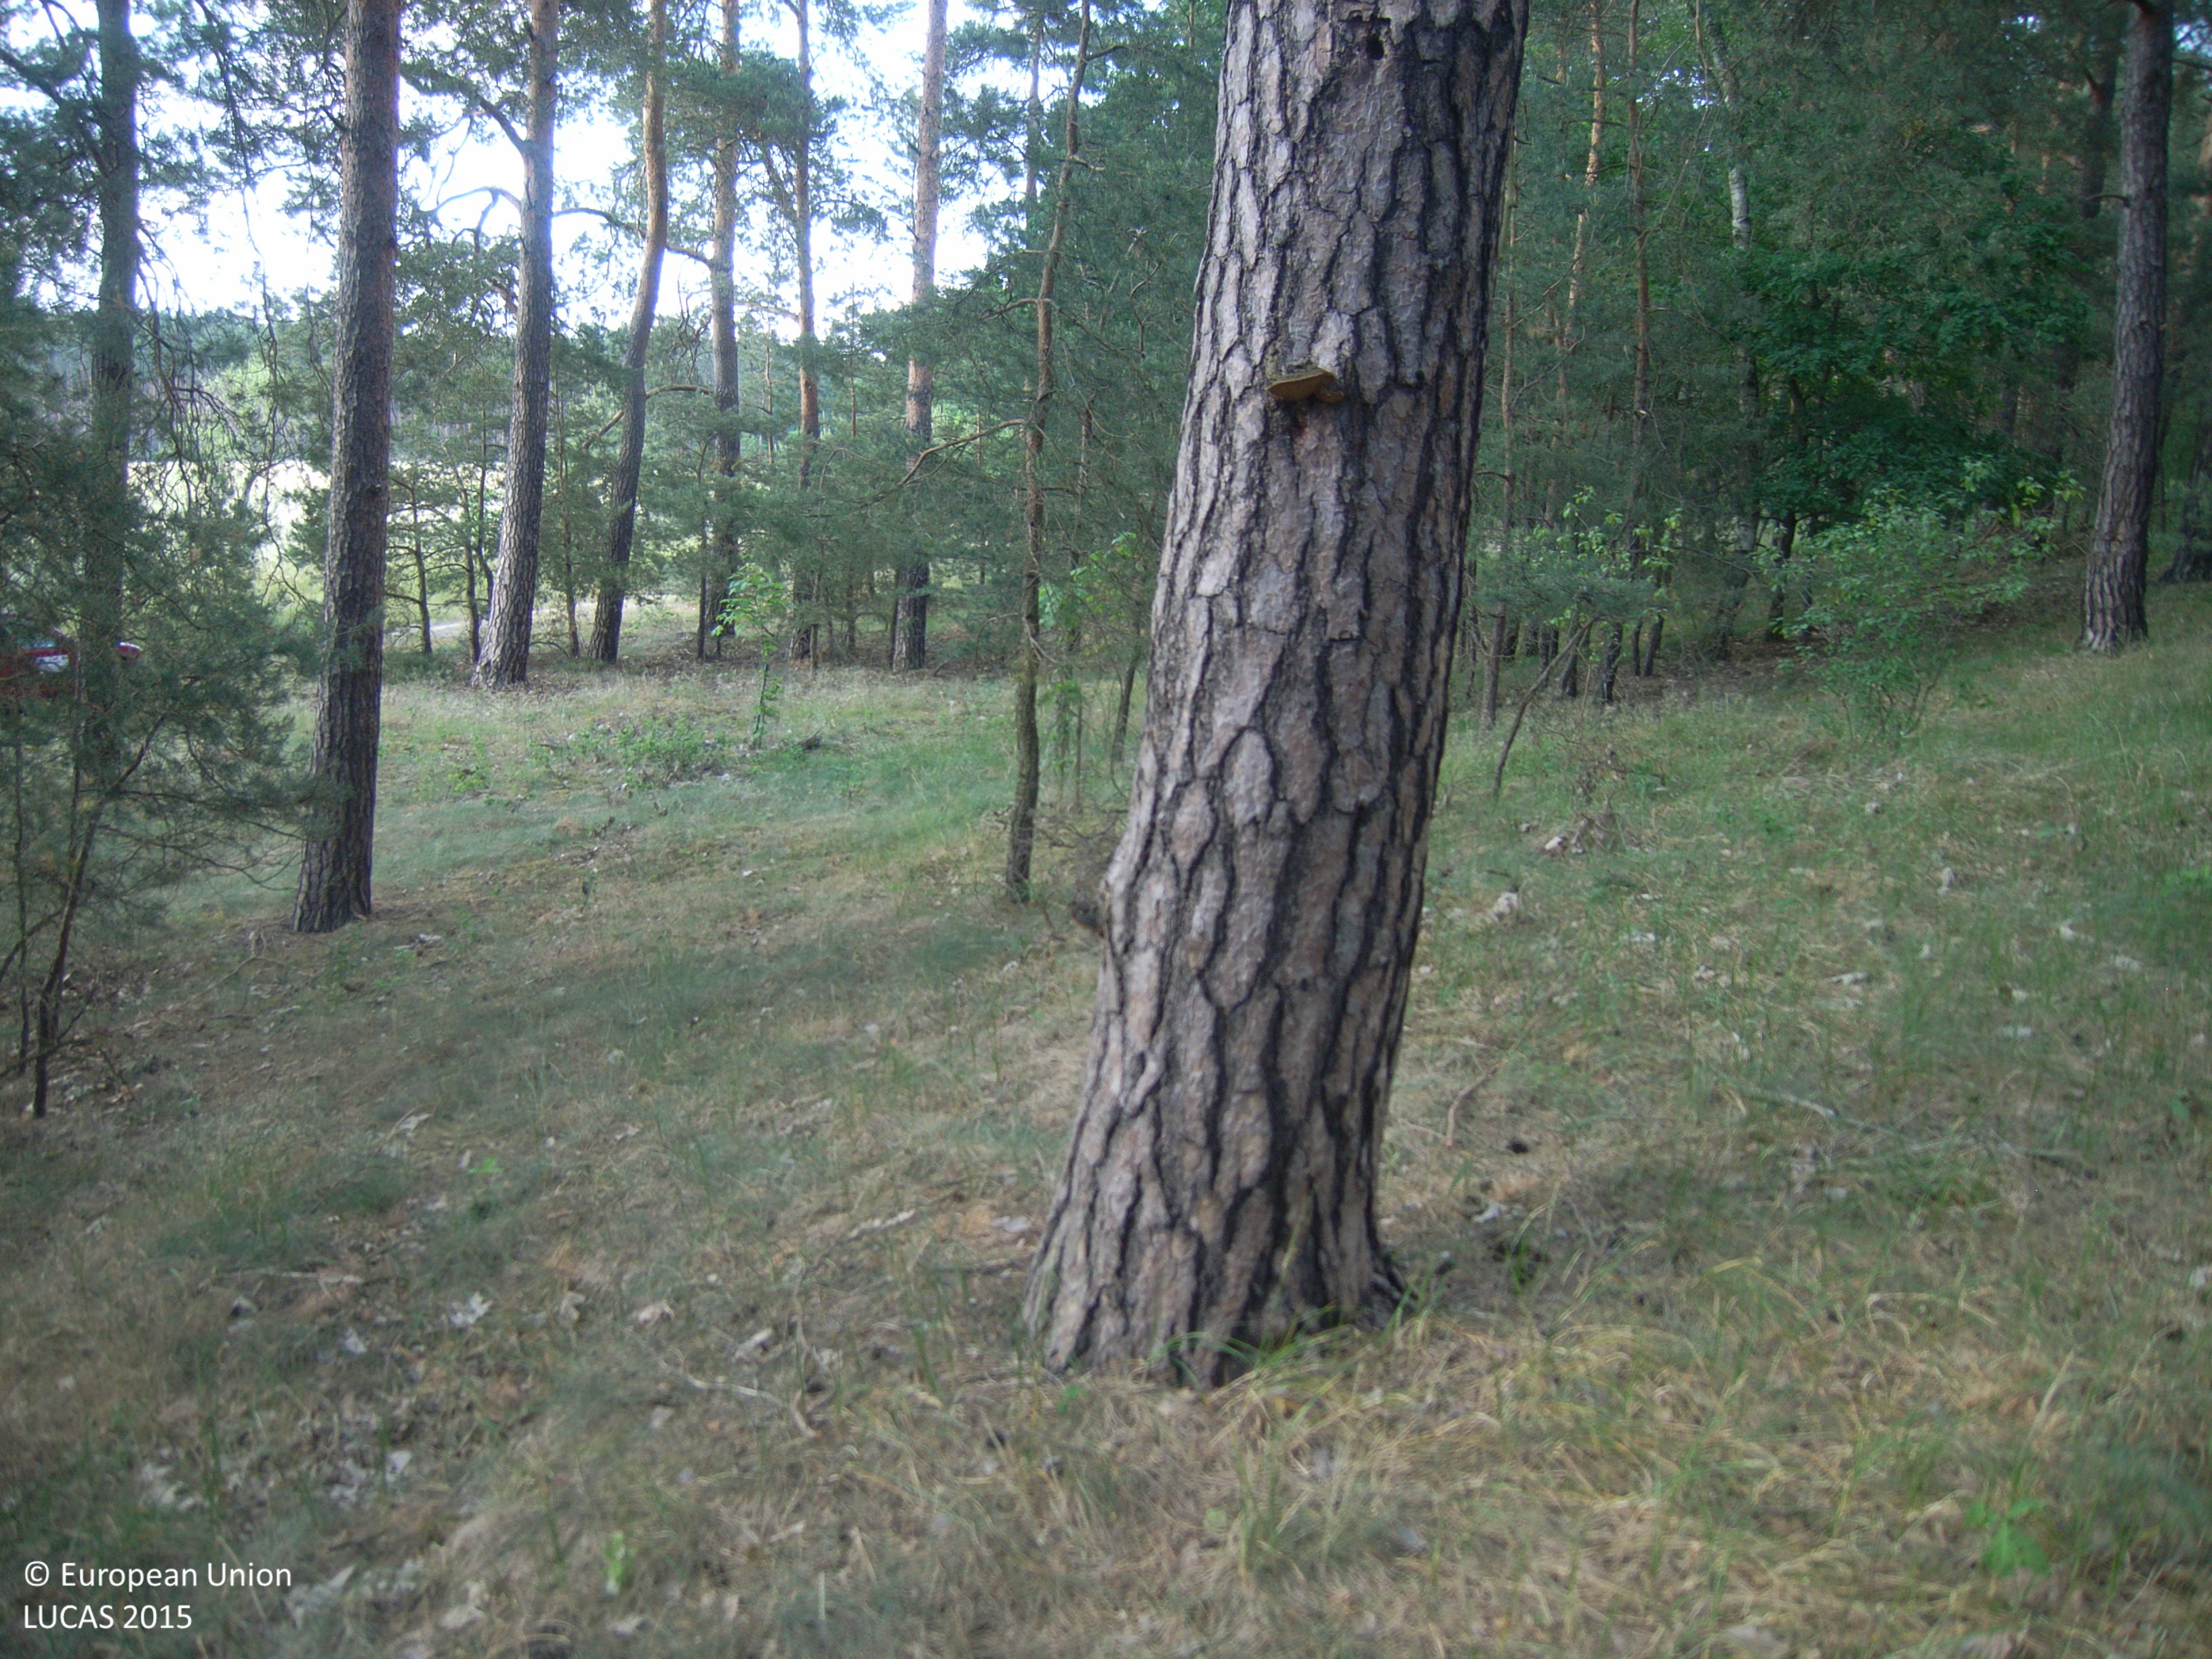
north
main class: Woodland
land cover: Pine dominated coniferous woodland
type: hemiboreal forest and nemoral coniferous forest and mixed broadleaved-coniferous forest
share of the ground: > 75 %
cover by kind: coniferous forest trees 95 %, herbaceous plants 5 %
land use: Forestry
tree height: > 5 m
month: June
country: DE
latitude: 52.0727
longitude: 14.1007
